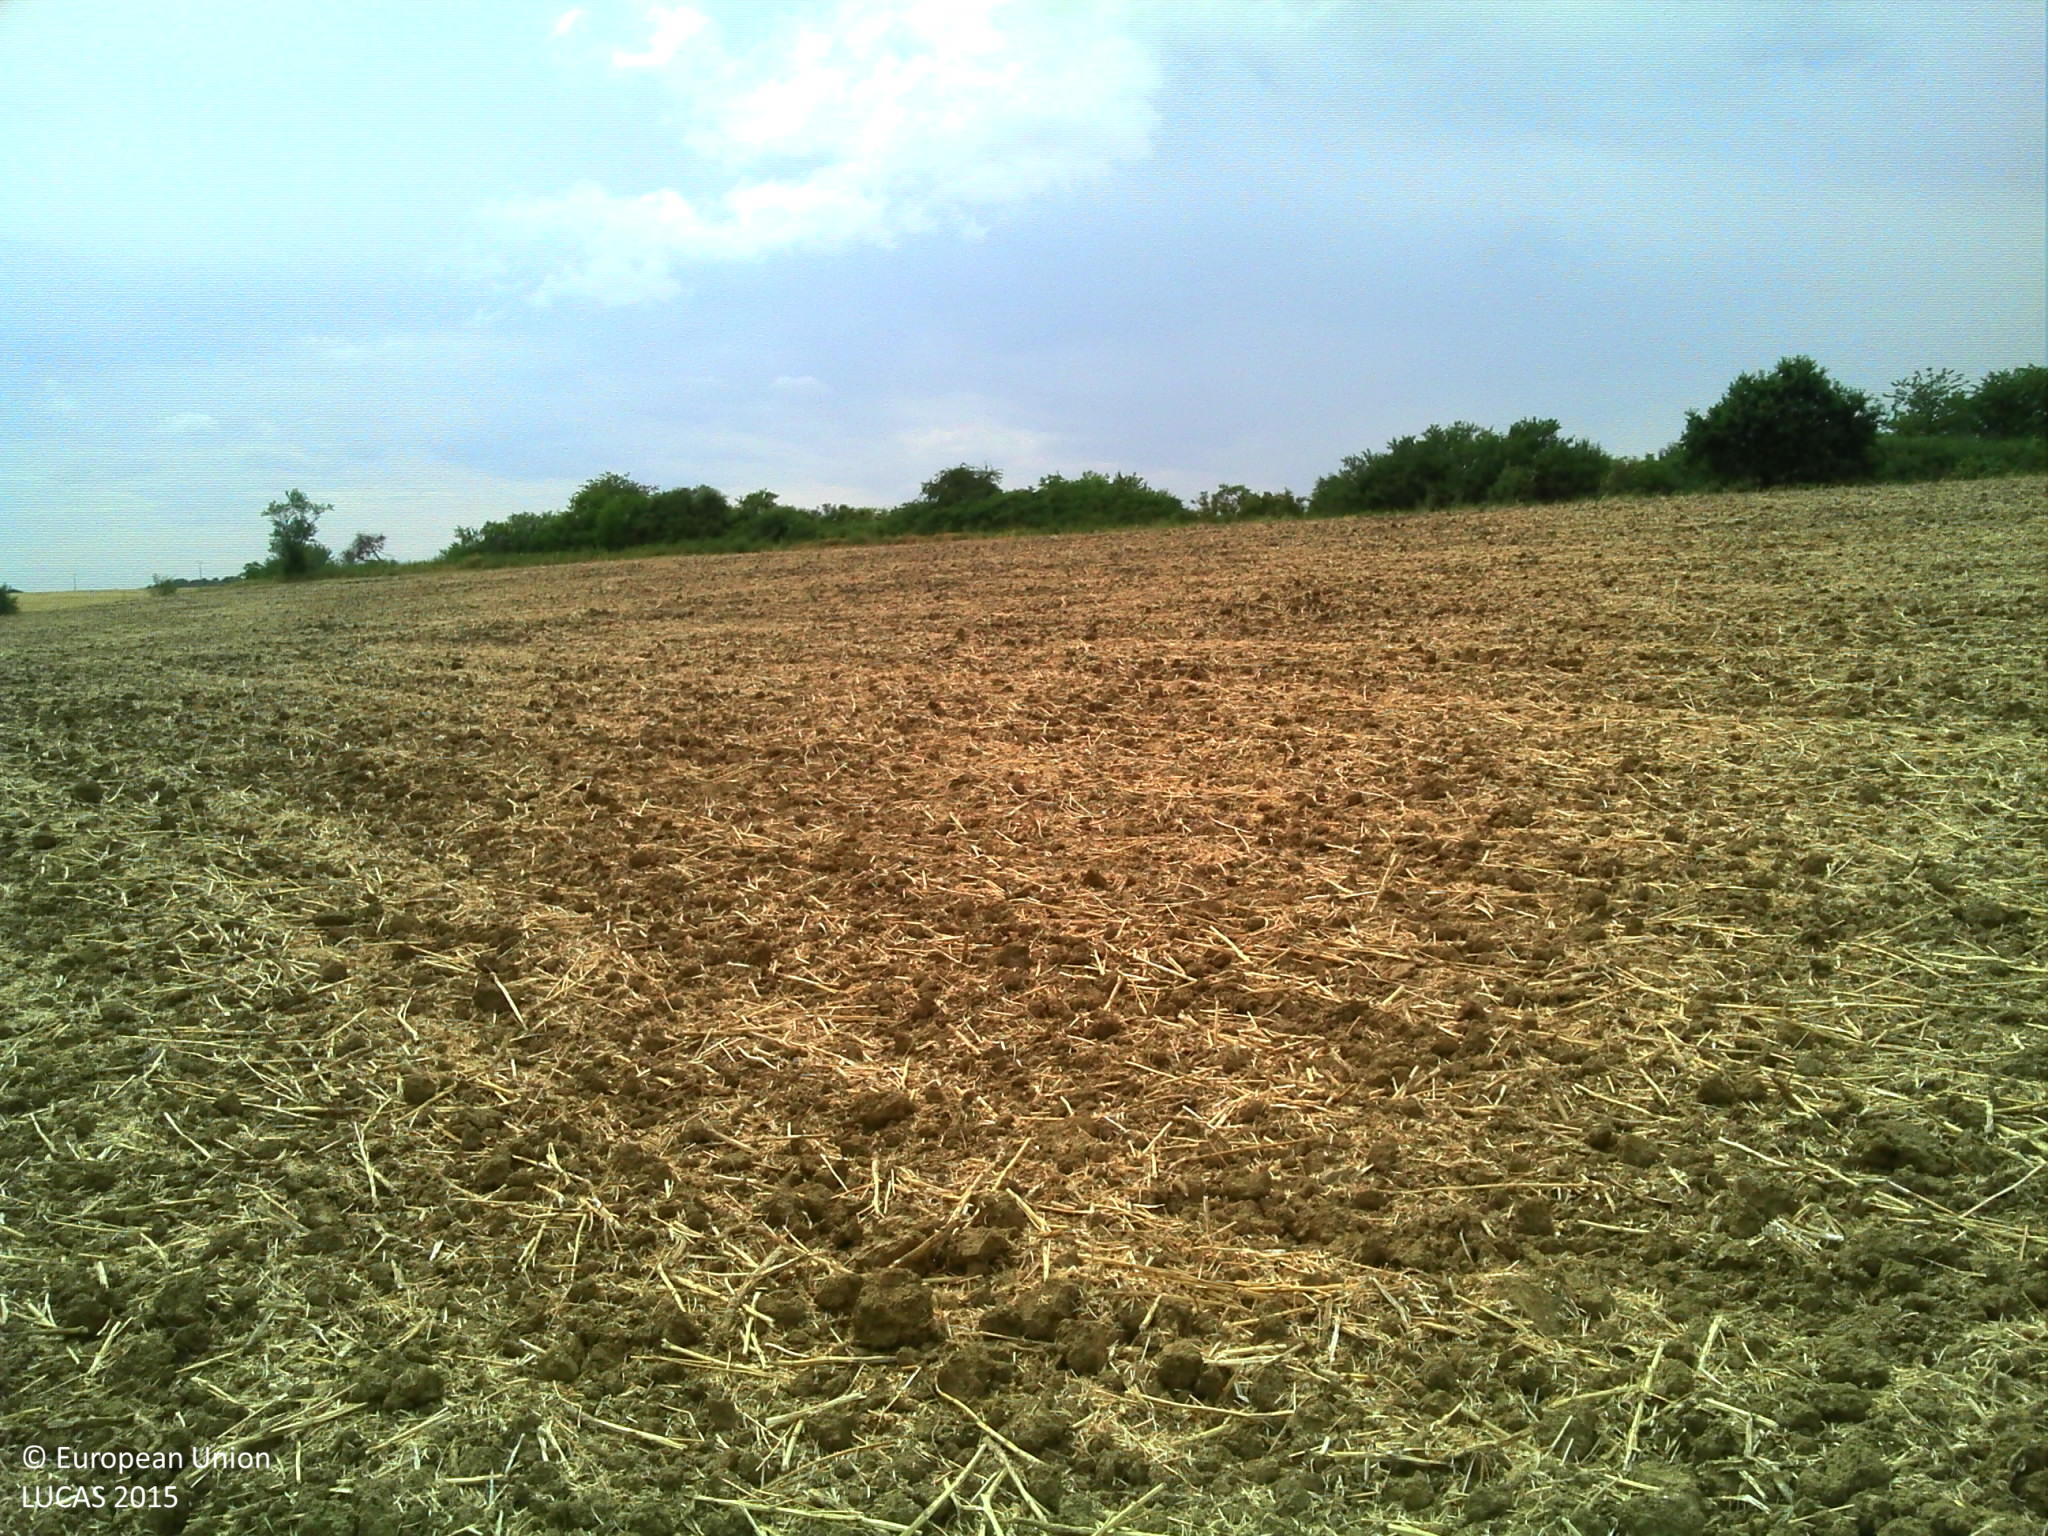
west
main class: Cropland
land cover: Rape and turnip rape
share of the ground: > 75 %
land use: Agriculture (excluding fallow land and kitchen gardens)
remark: Harvested field
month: July
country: FR
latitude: 48.3896
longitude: 6.1245
